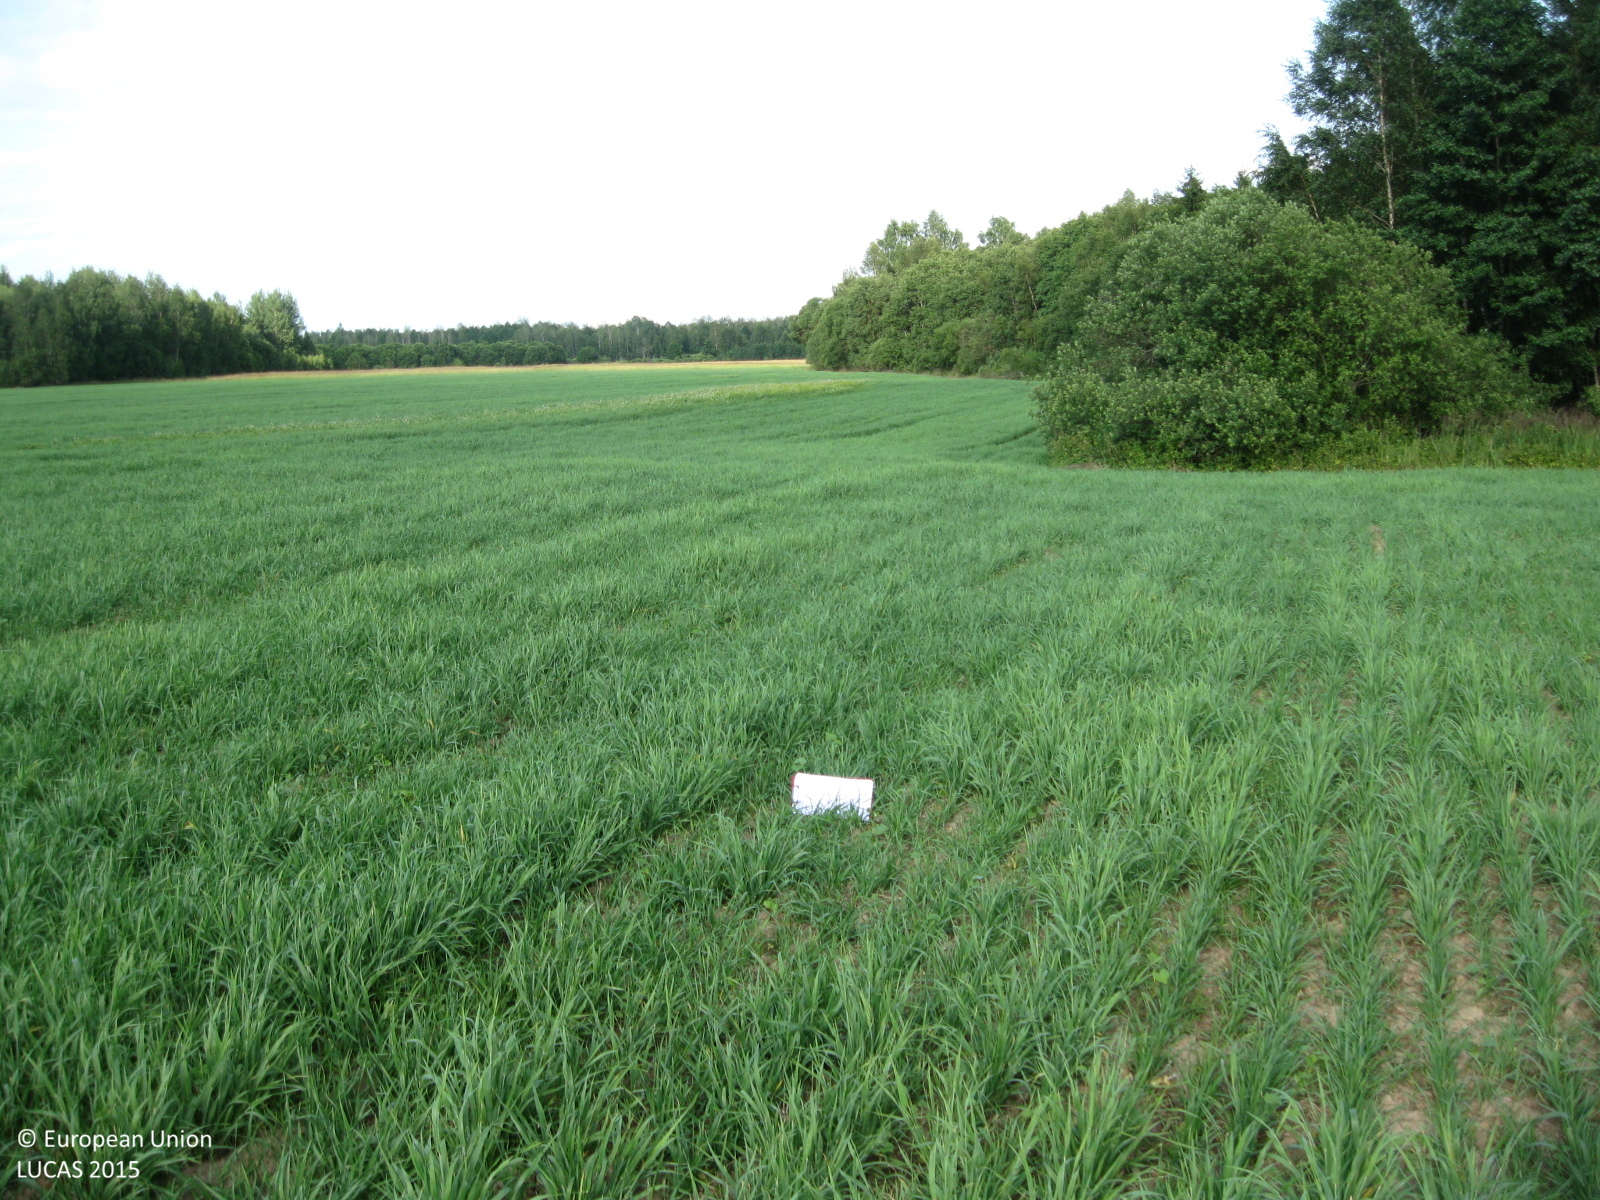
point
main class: Cropland
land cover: Barley
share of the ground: > 75 %
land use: Agriculture (excluding fallow land and kitchen gardens)
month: July
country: LT
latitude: 55.4697
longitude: 24.6406
